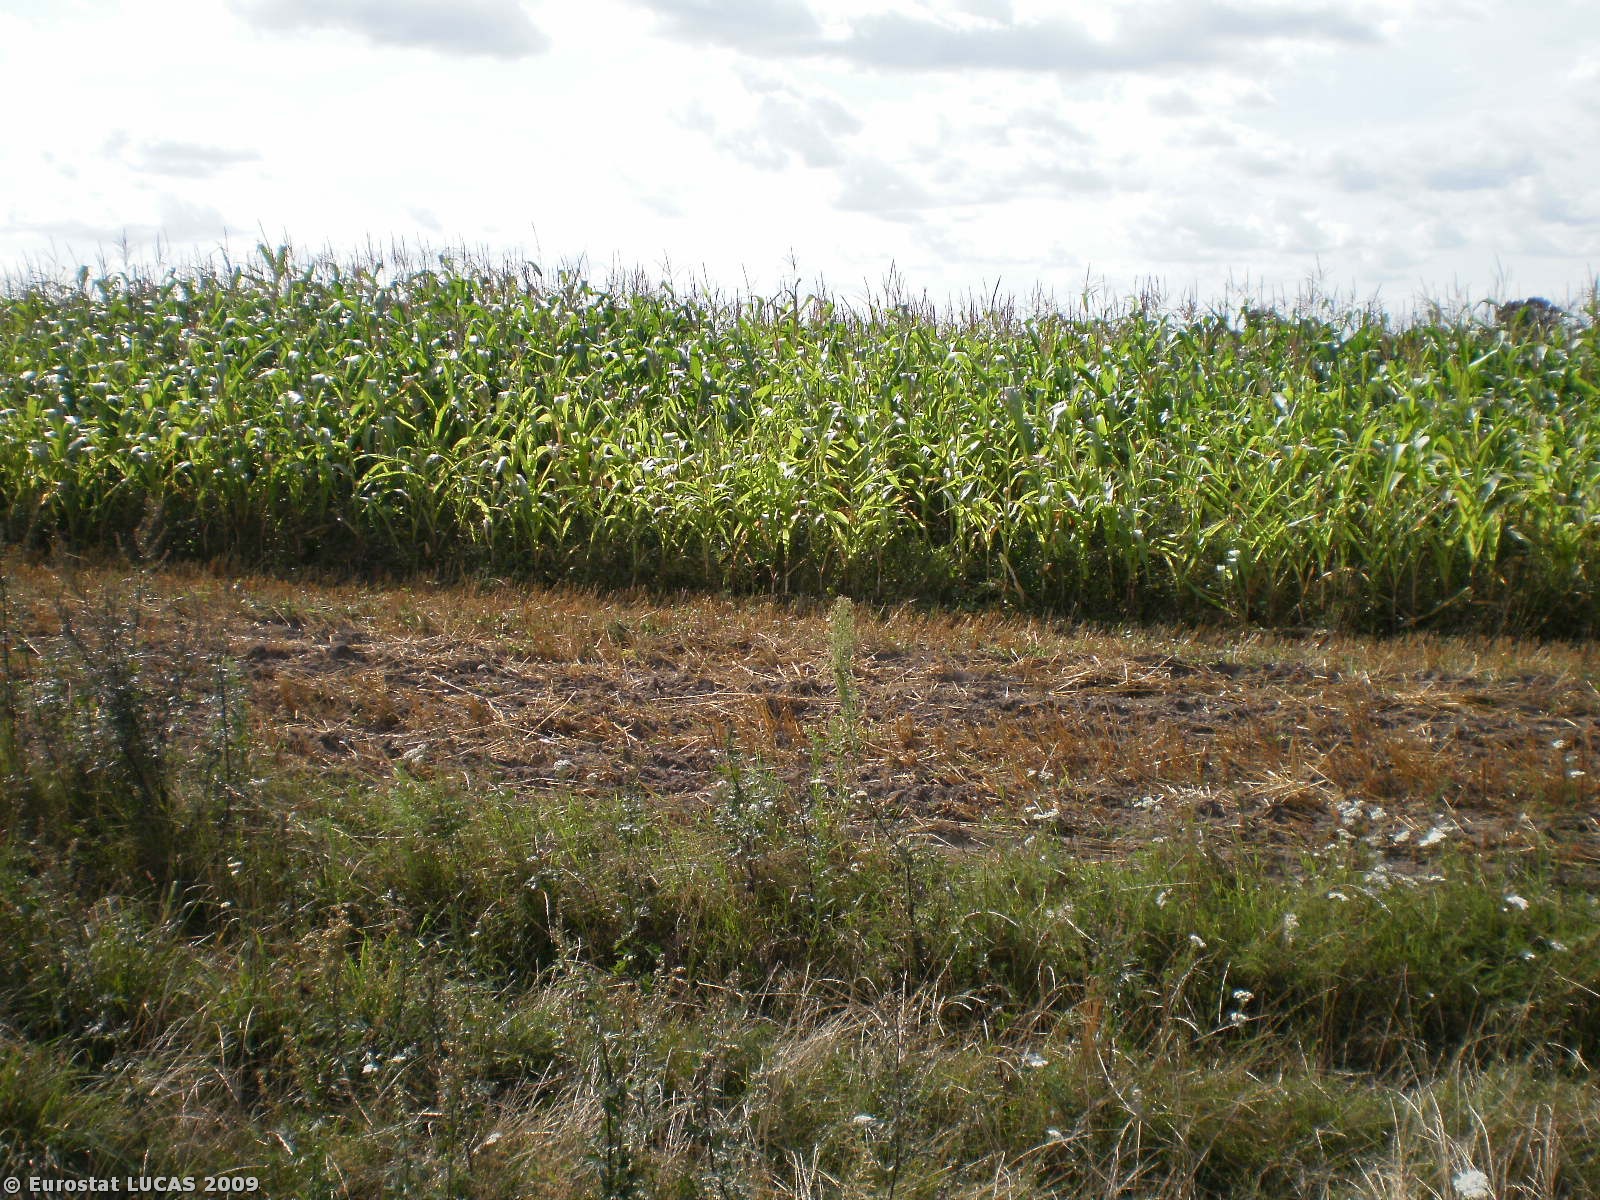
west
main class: Cropland
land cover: Rye
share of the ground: < 10 %
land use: Agriculture (excluding fallow land and kitchen gardens)
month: August
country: PL
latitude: 53.0710
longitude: 21.8615
